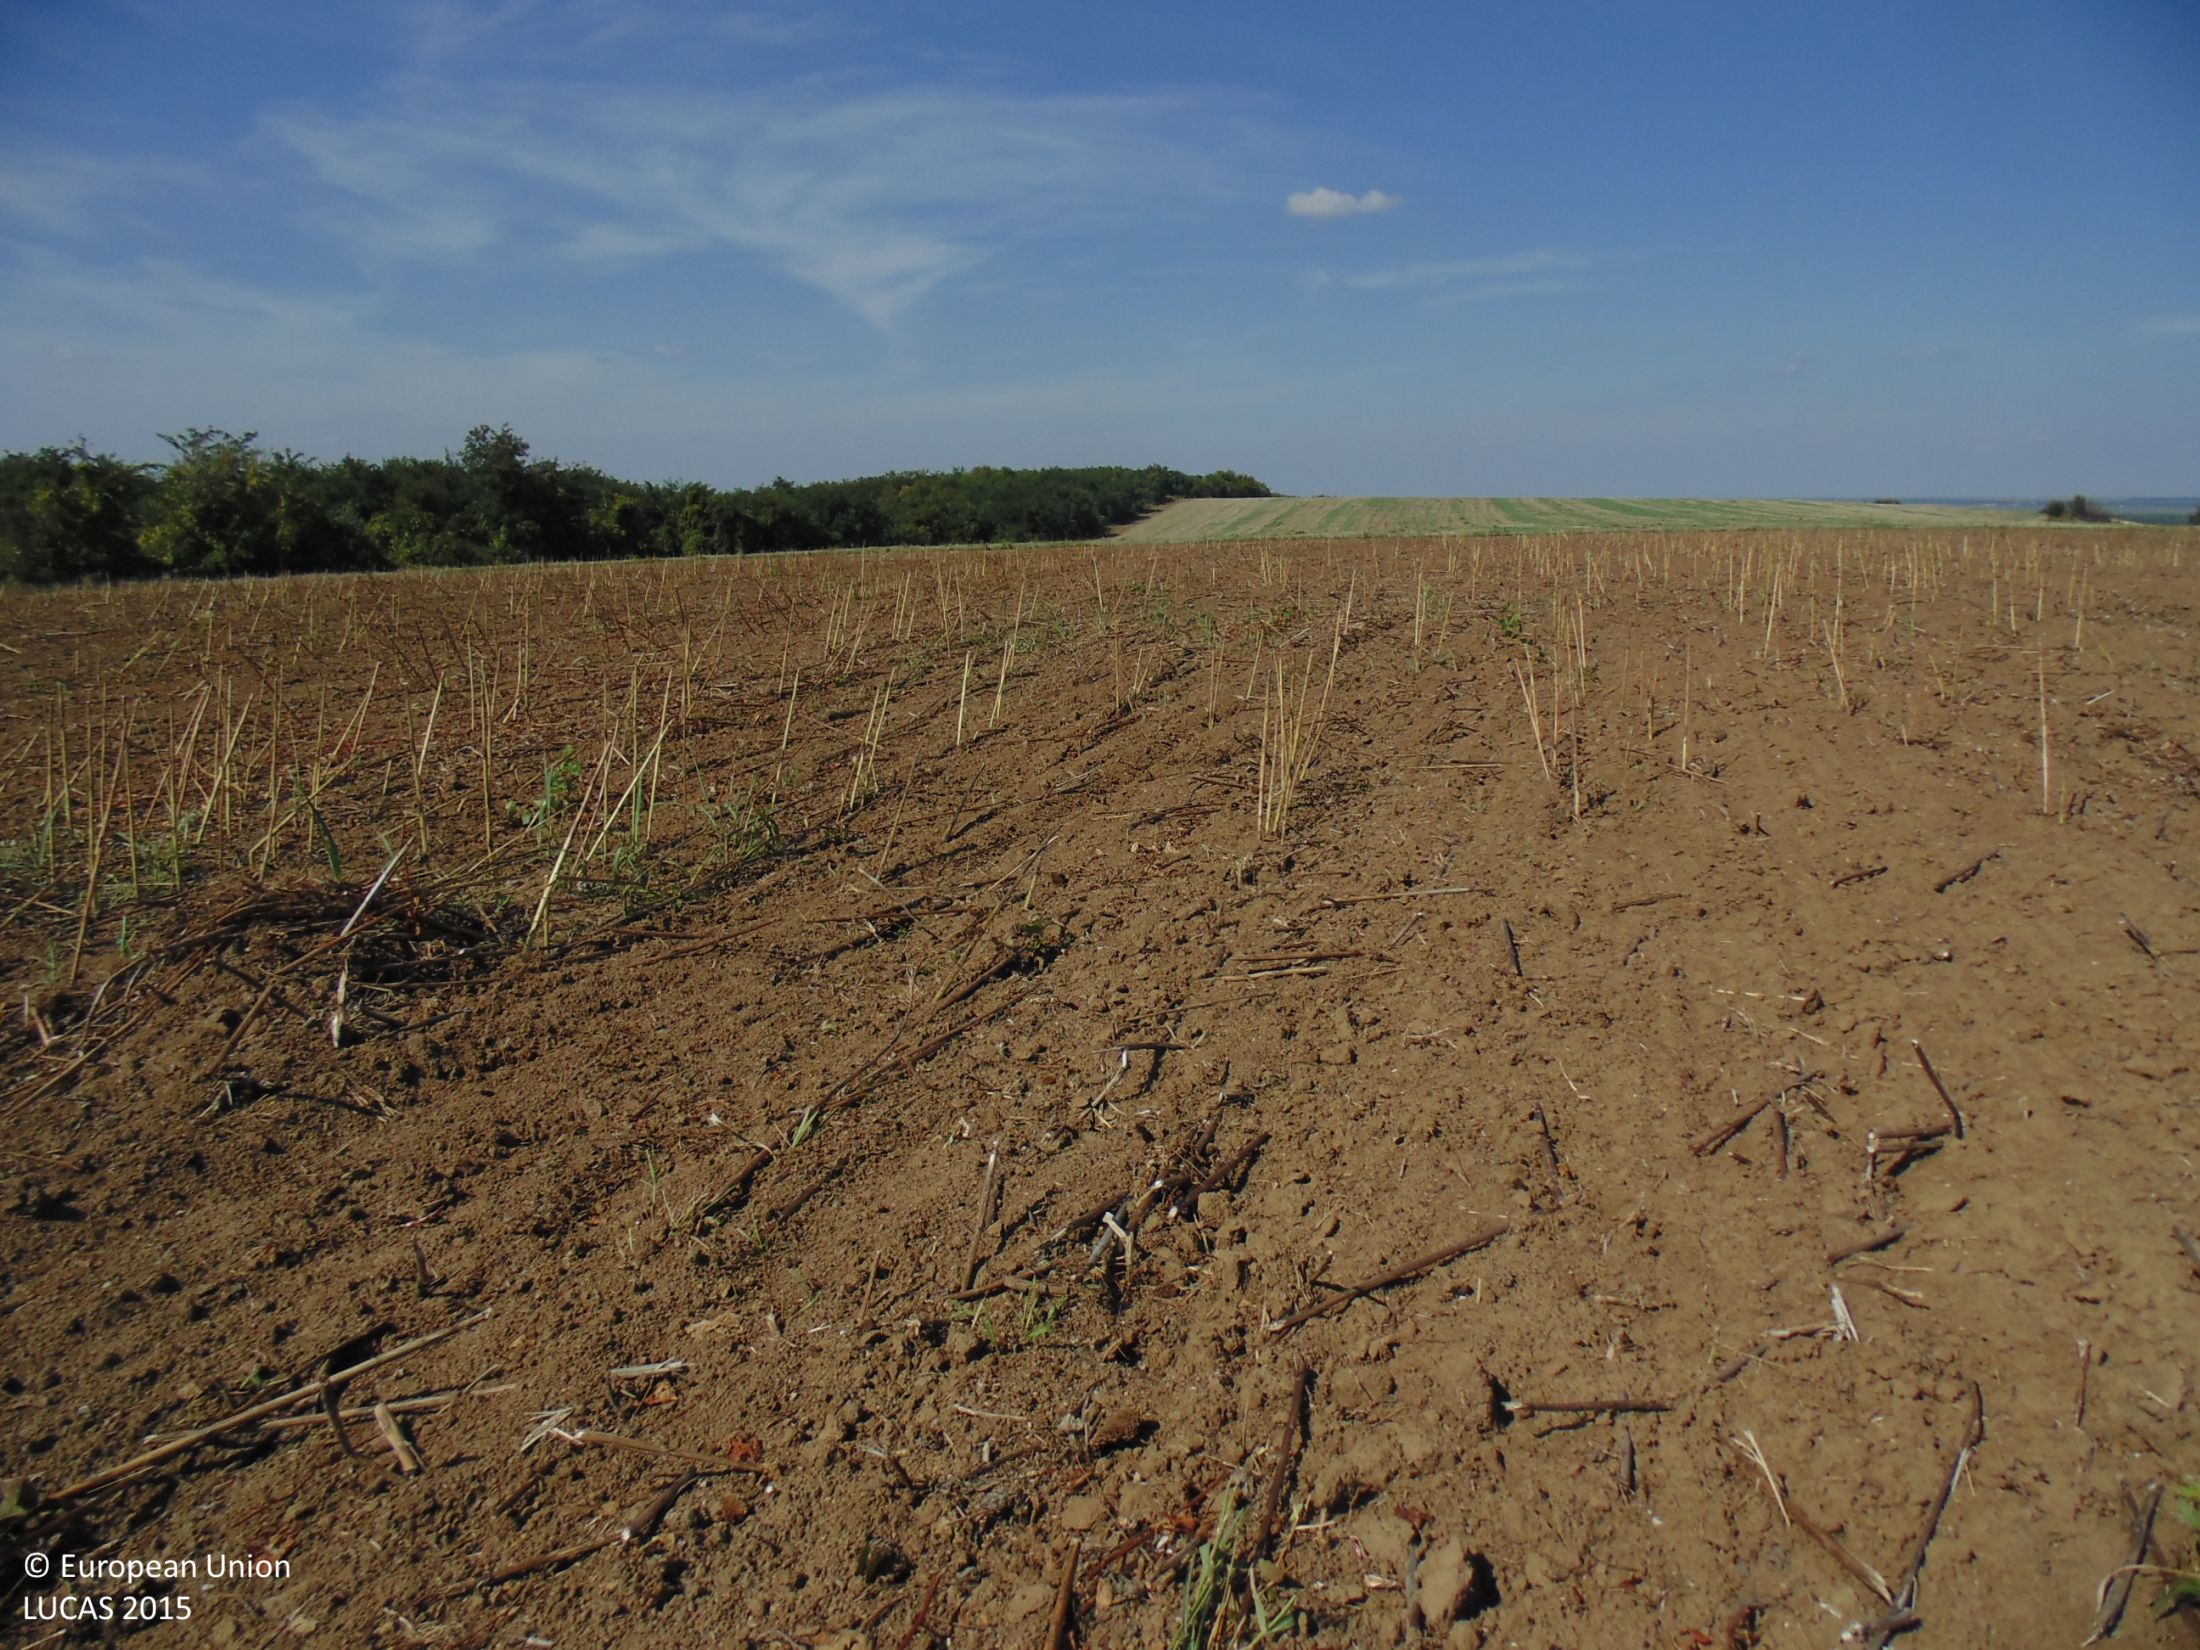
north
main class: Cropland
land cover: Sunflower
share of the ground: < 10 %
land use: Agriculture (excluding fallow land and kitchen gardens)
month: September
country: BG
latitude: 44.1068
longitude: 26.9260
